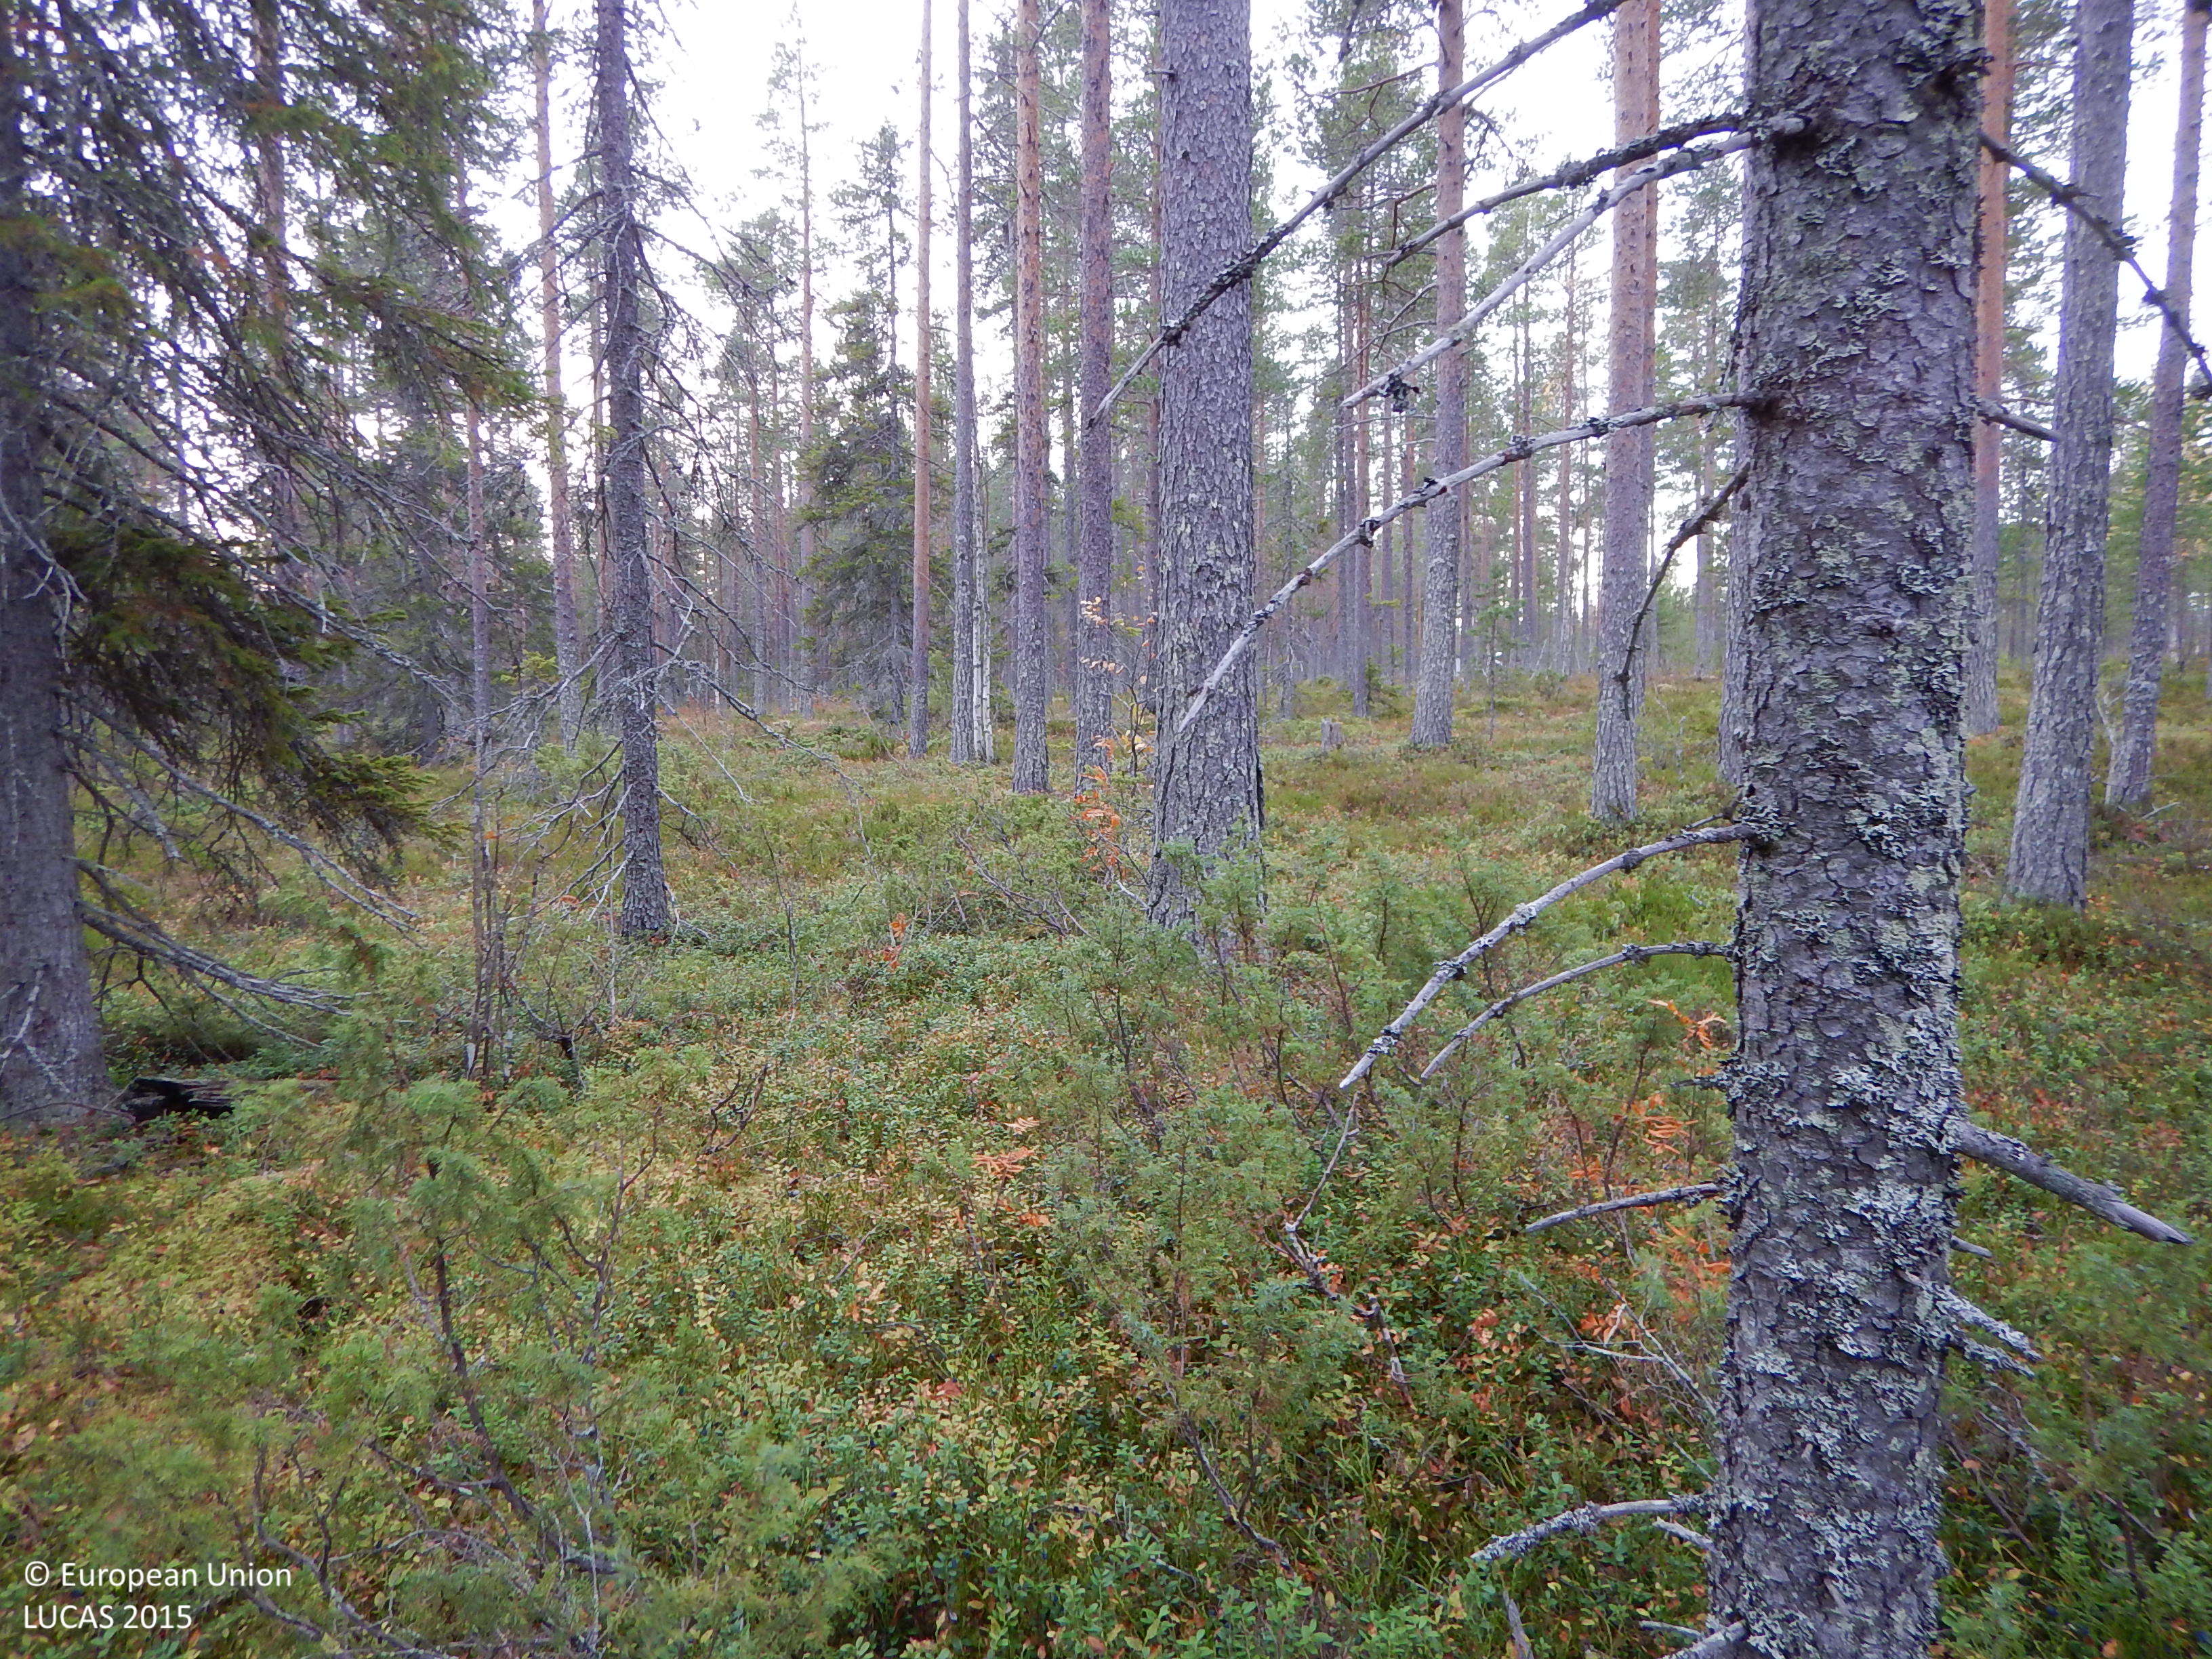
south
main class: Woodland
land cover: Other coniferous woodland
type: boreal forest
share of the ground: 50 - 75 %
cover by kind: coniferous forest trees 60 %, shrubs 20 %, herbaceous plants 10 %, lichens and mosses 10 %
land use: Forestry
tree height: > 5 m
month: October
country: SE
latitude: 65.2077
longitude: 21.1957
